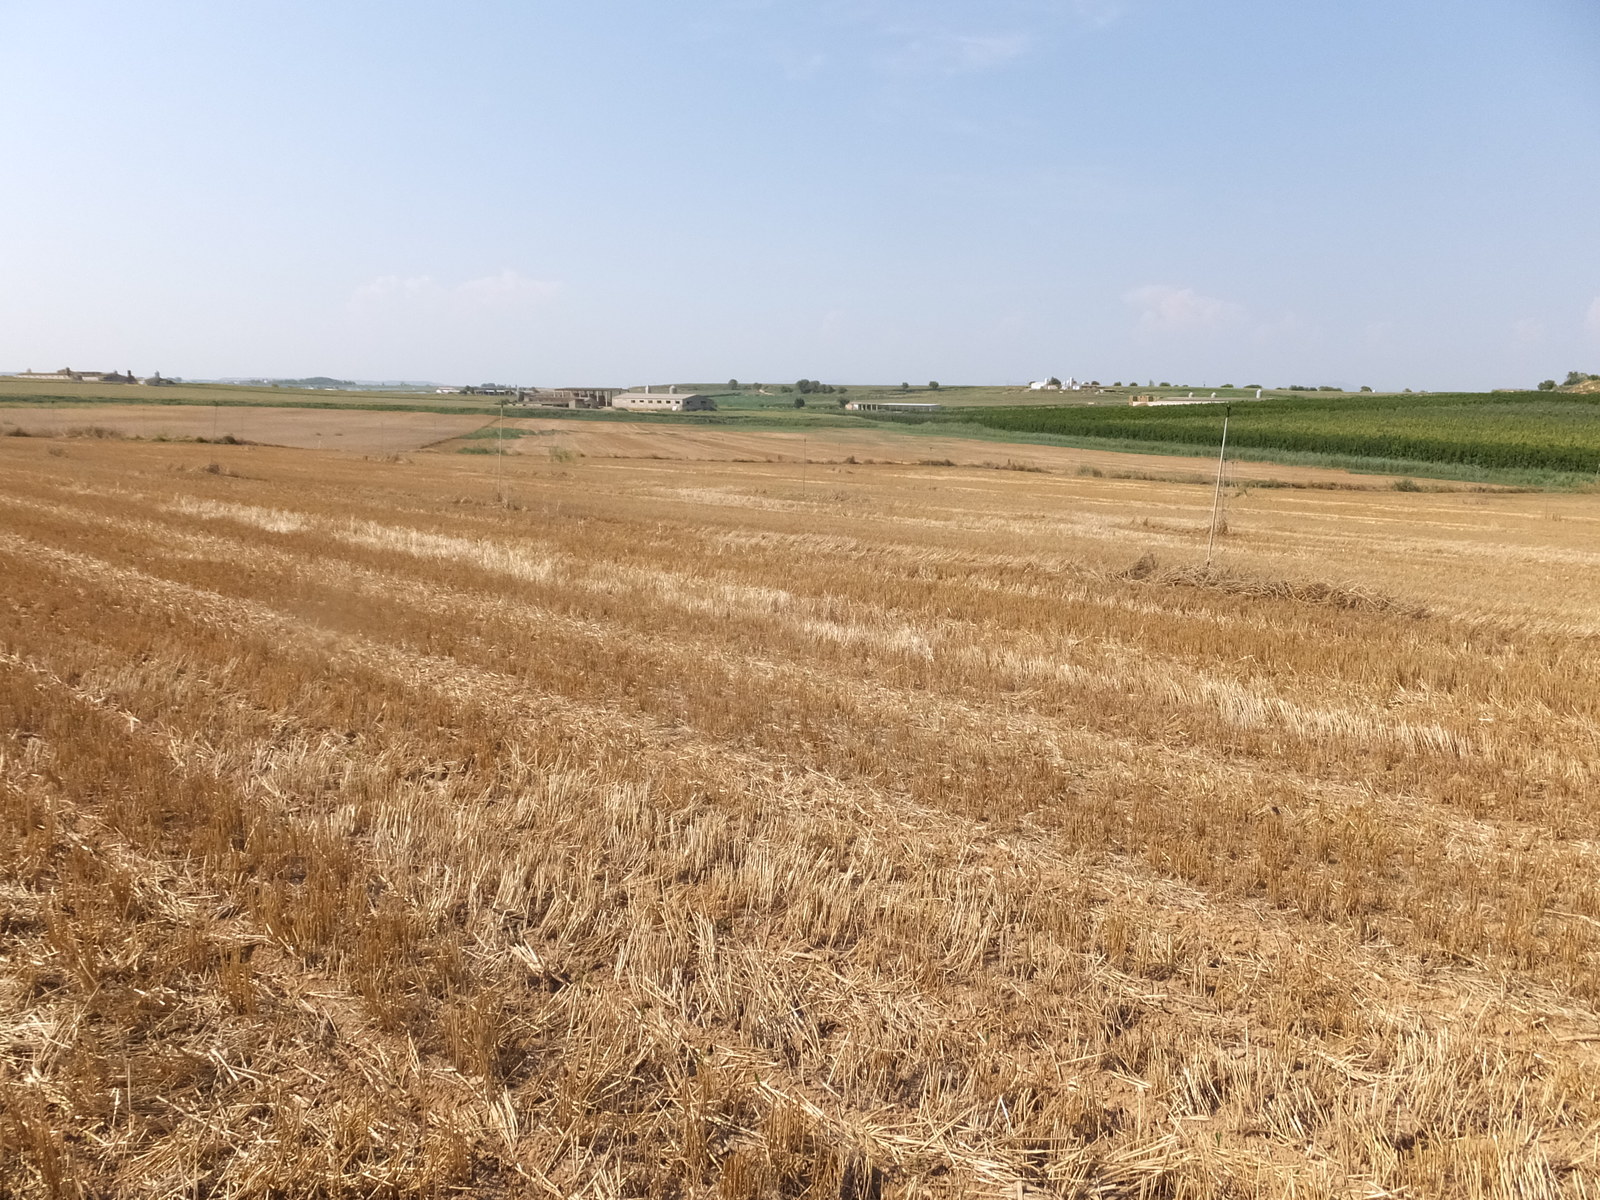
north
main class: Cropland
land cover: Maize
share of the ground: < 10 %
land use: Agriculture (excluding fallow land and kitchen gardens)
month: July
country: ES
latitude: 41.7001
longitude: 0.3363
